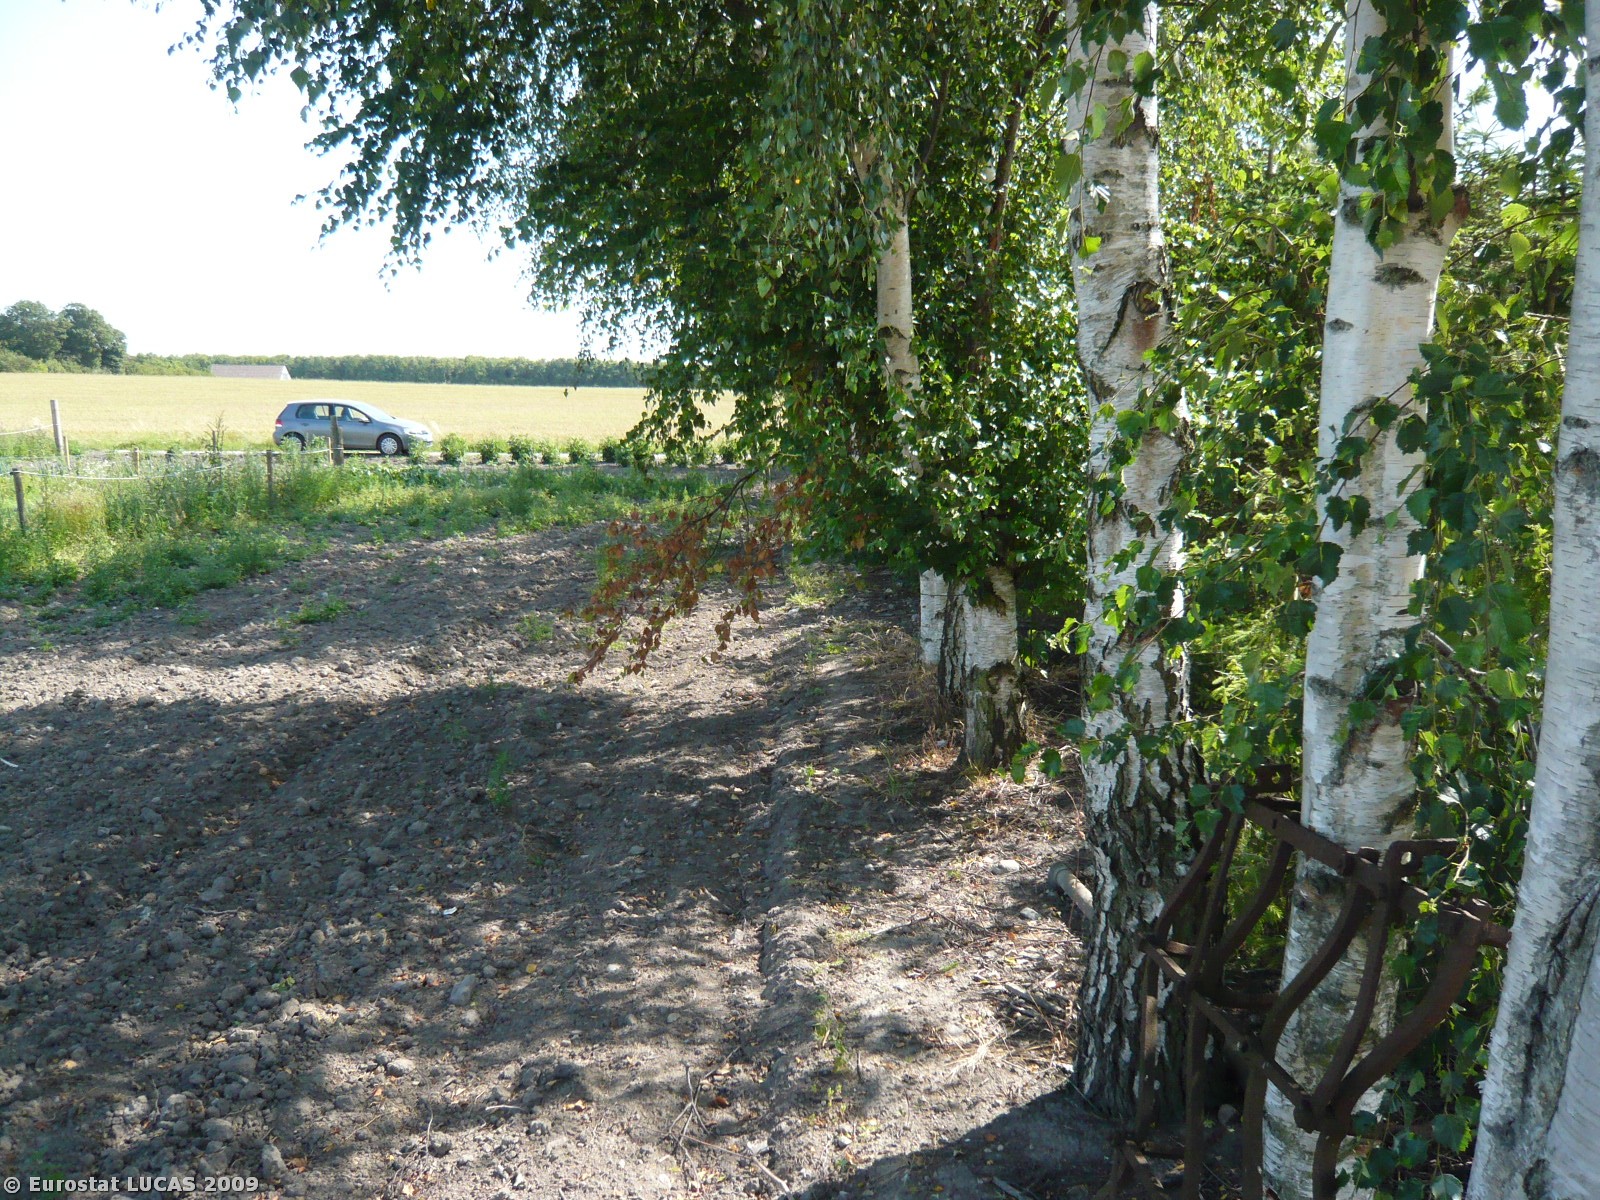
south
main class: Cropland
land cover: Barley
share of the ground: > 75 %
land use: Agriculture (excluding fallow land and kitchen gardens)
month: July
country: DK
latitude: 55.7301
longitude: 11.4477
